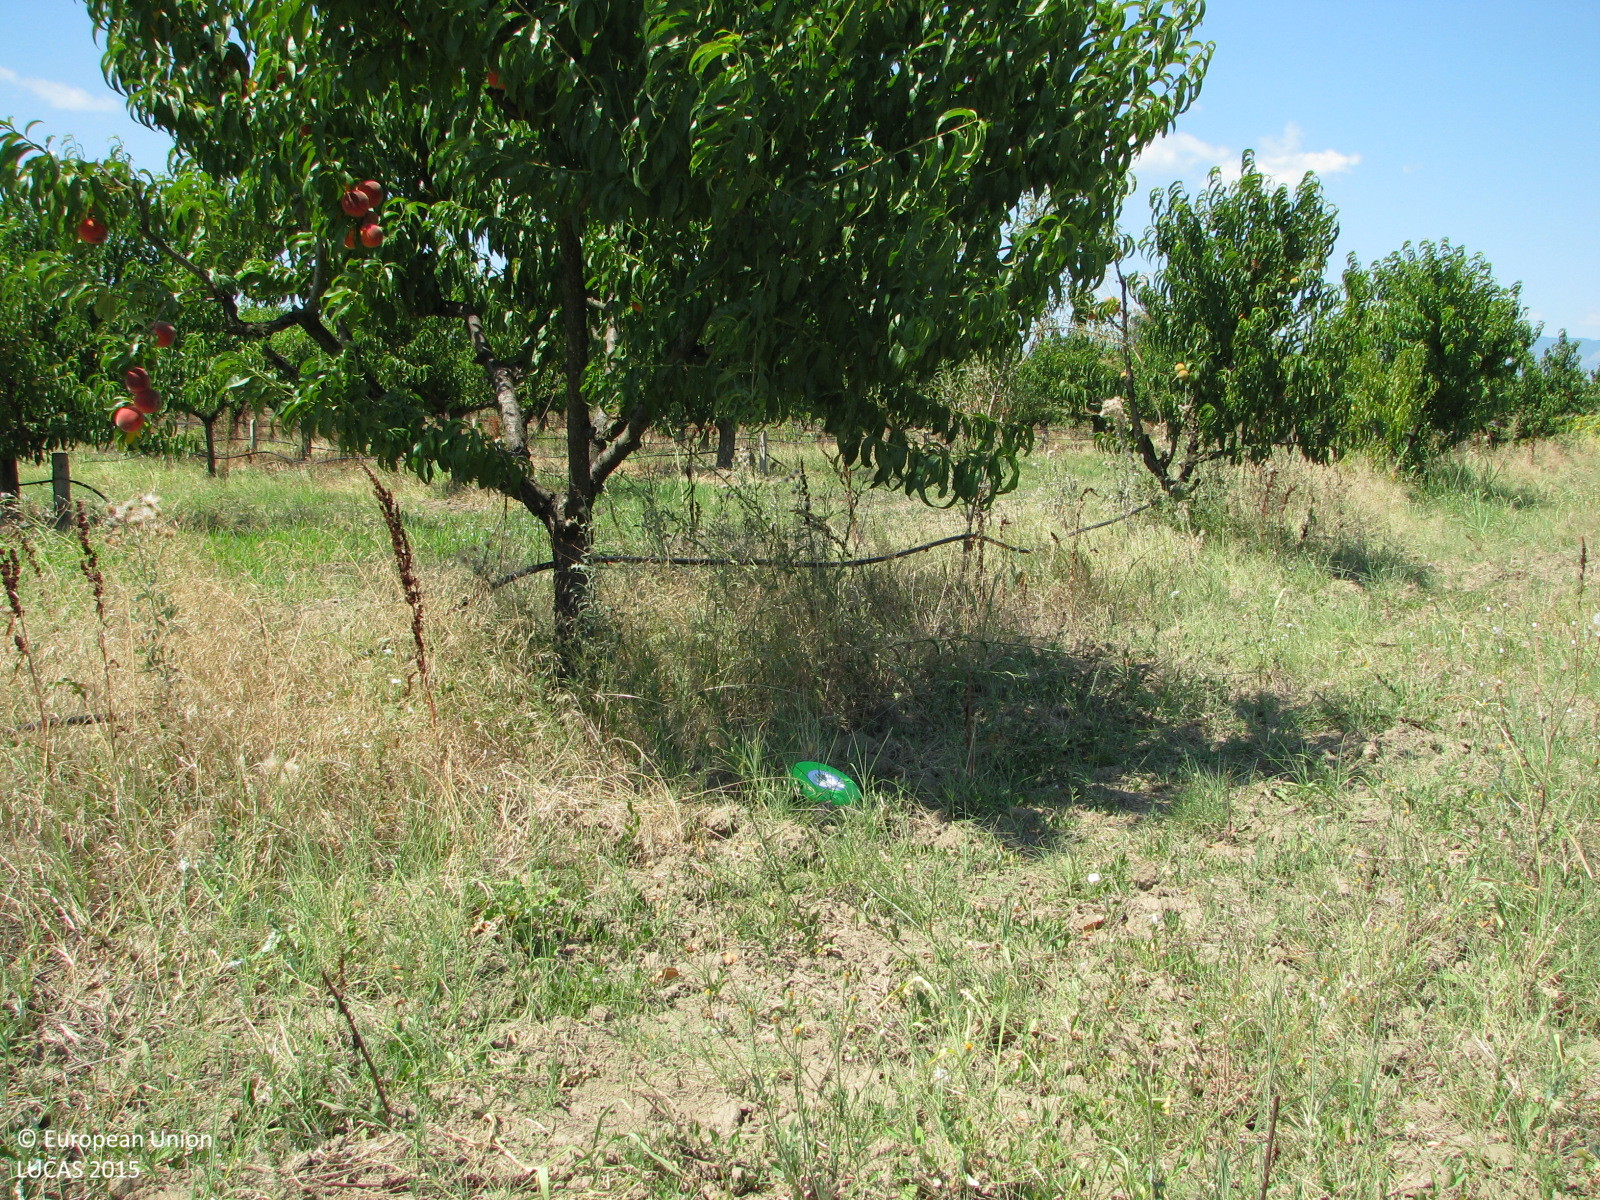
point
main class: Cropland
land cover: Other fruit trees and berries
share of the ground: 25 - 50 %
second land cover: Spontaneously vegetated surfaces
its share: > 75 %
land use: Agriculture (excluding fallow land and kitchen gardens)
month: July
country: BG
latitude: 42.5728
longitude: 26.3038
